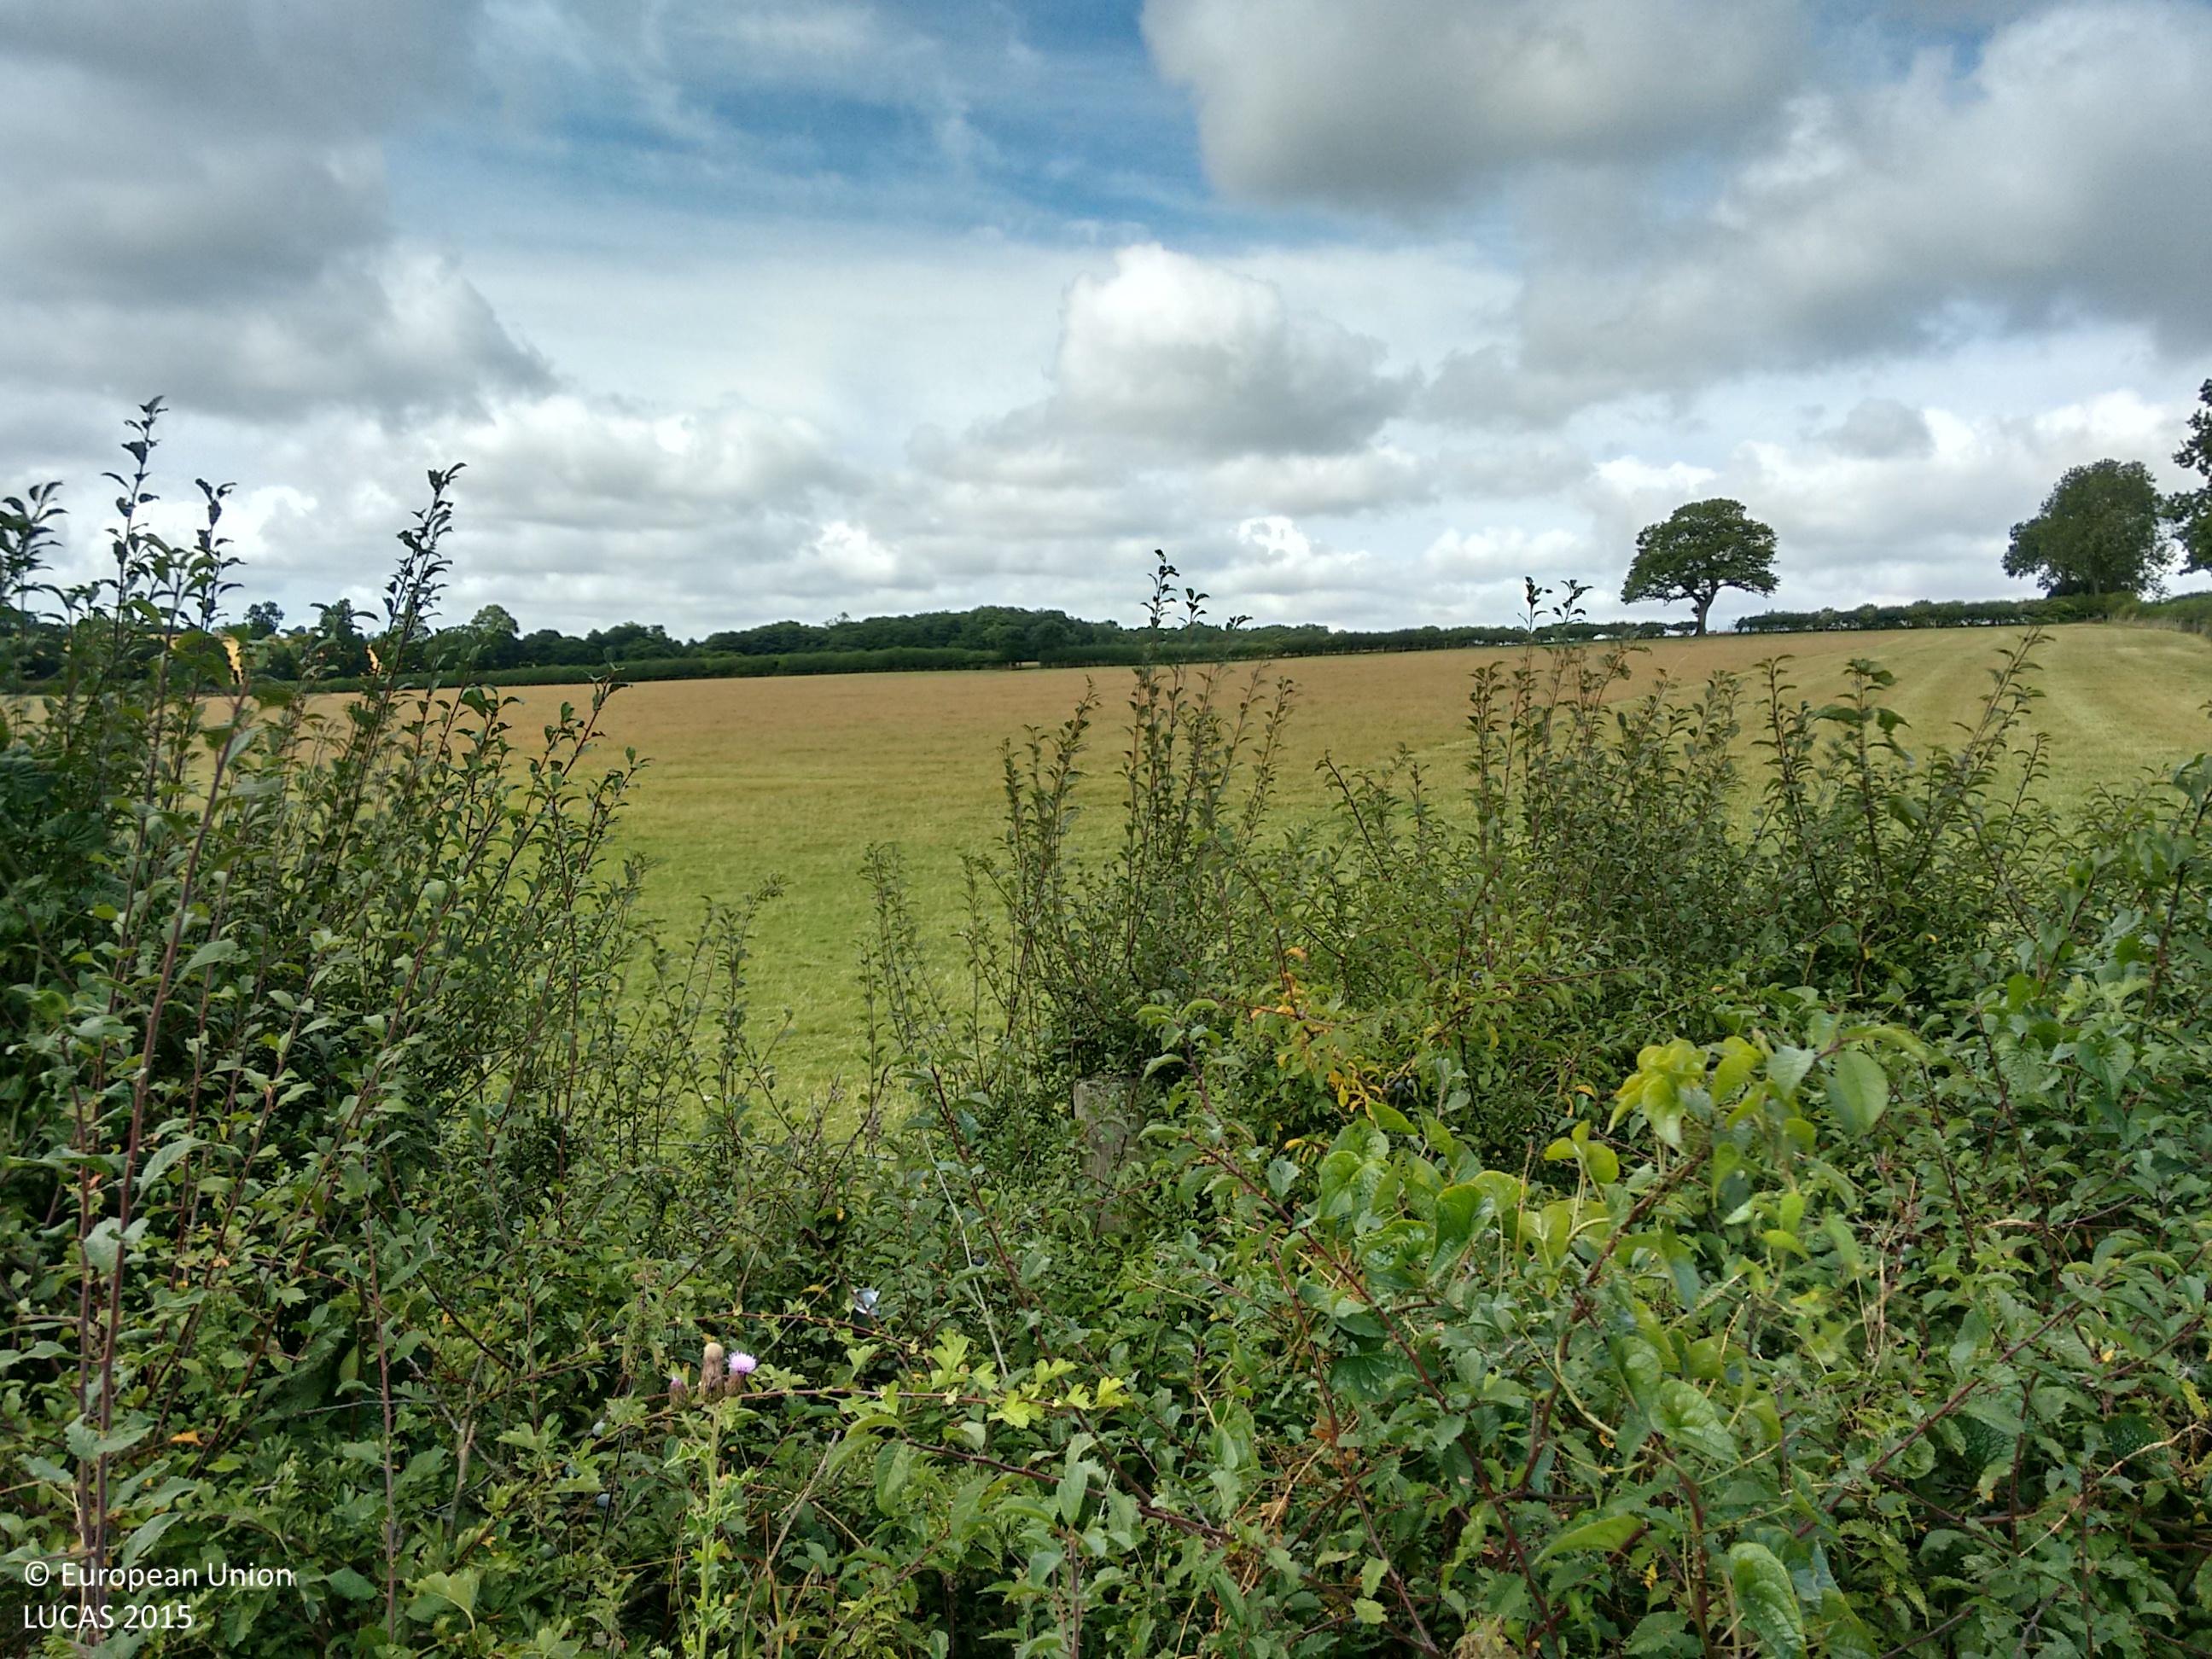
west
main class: Grassland
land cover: Grassland without tree/shrub cover
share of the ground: > 75 %
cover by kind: herbaceous plants 100 %
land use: Agriculture (excluding fallow land and kitchen gardens)
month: August
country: GB
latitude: 52.3221
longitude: -1.1526
